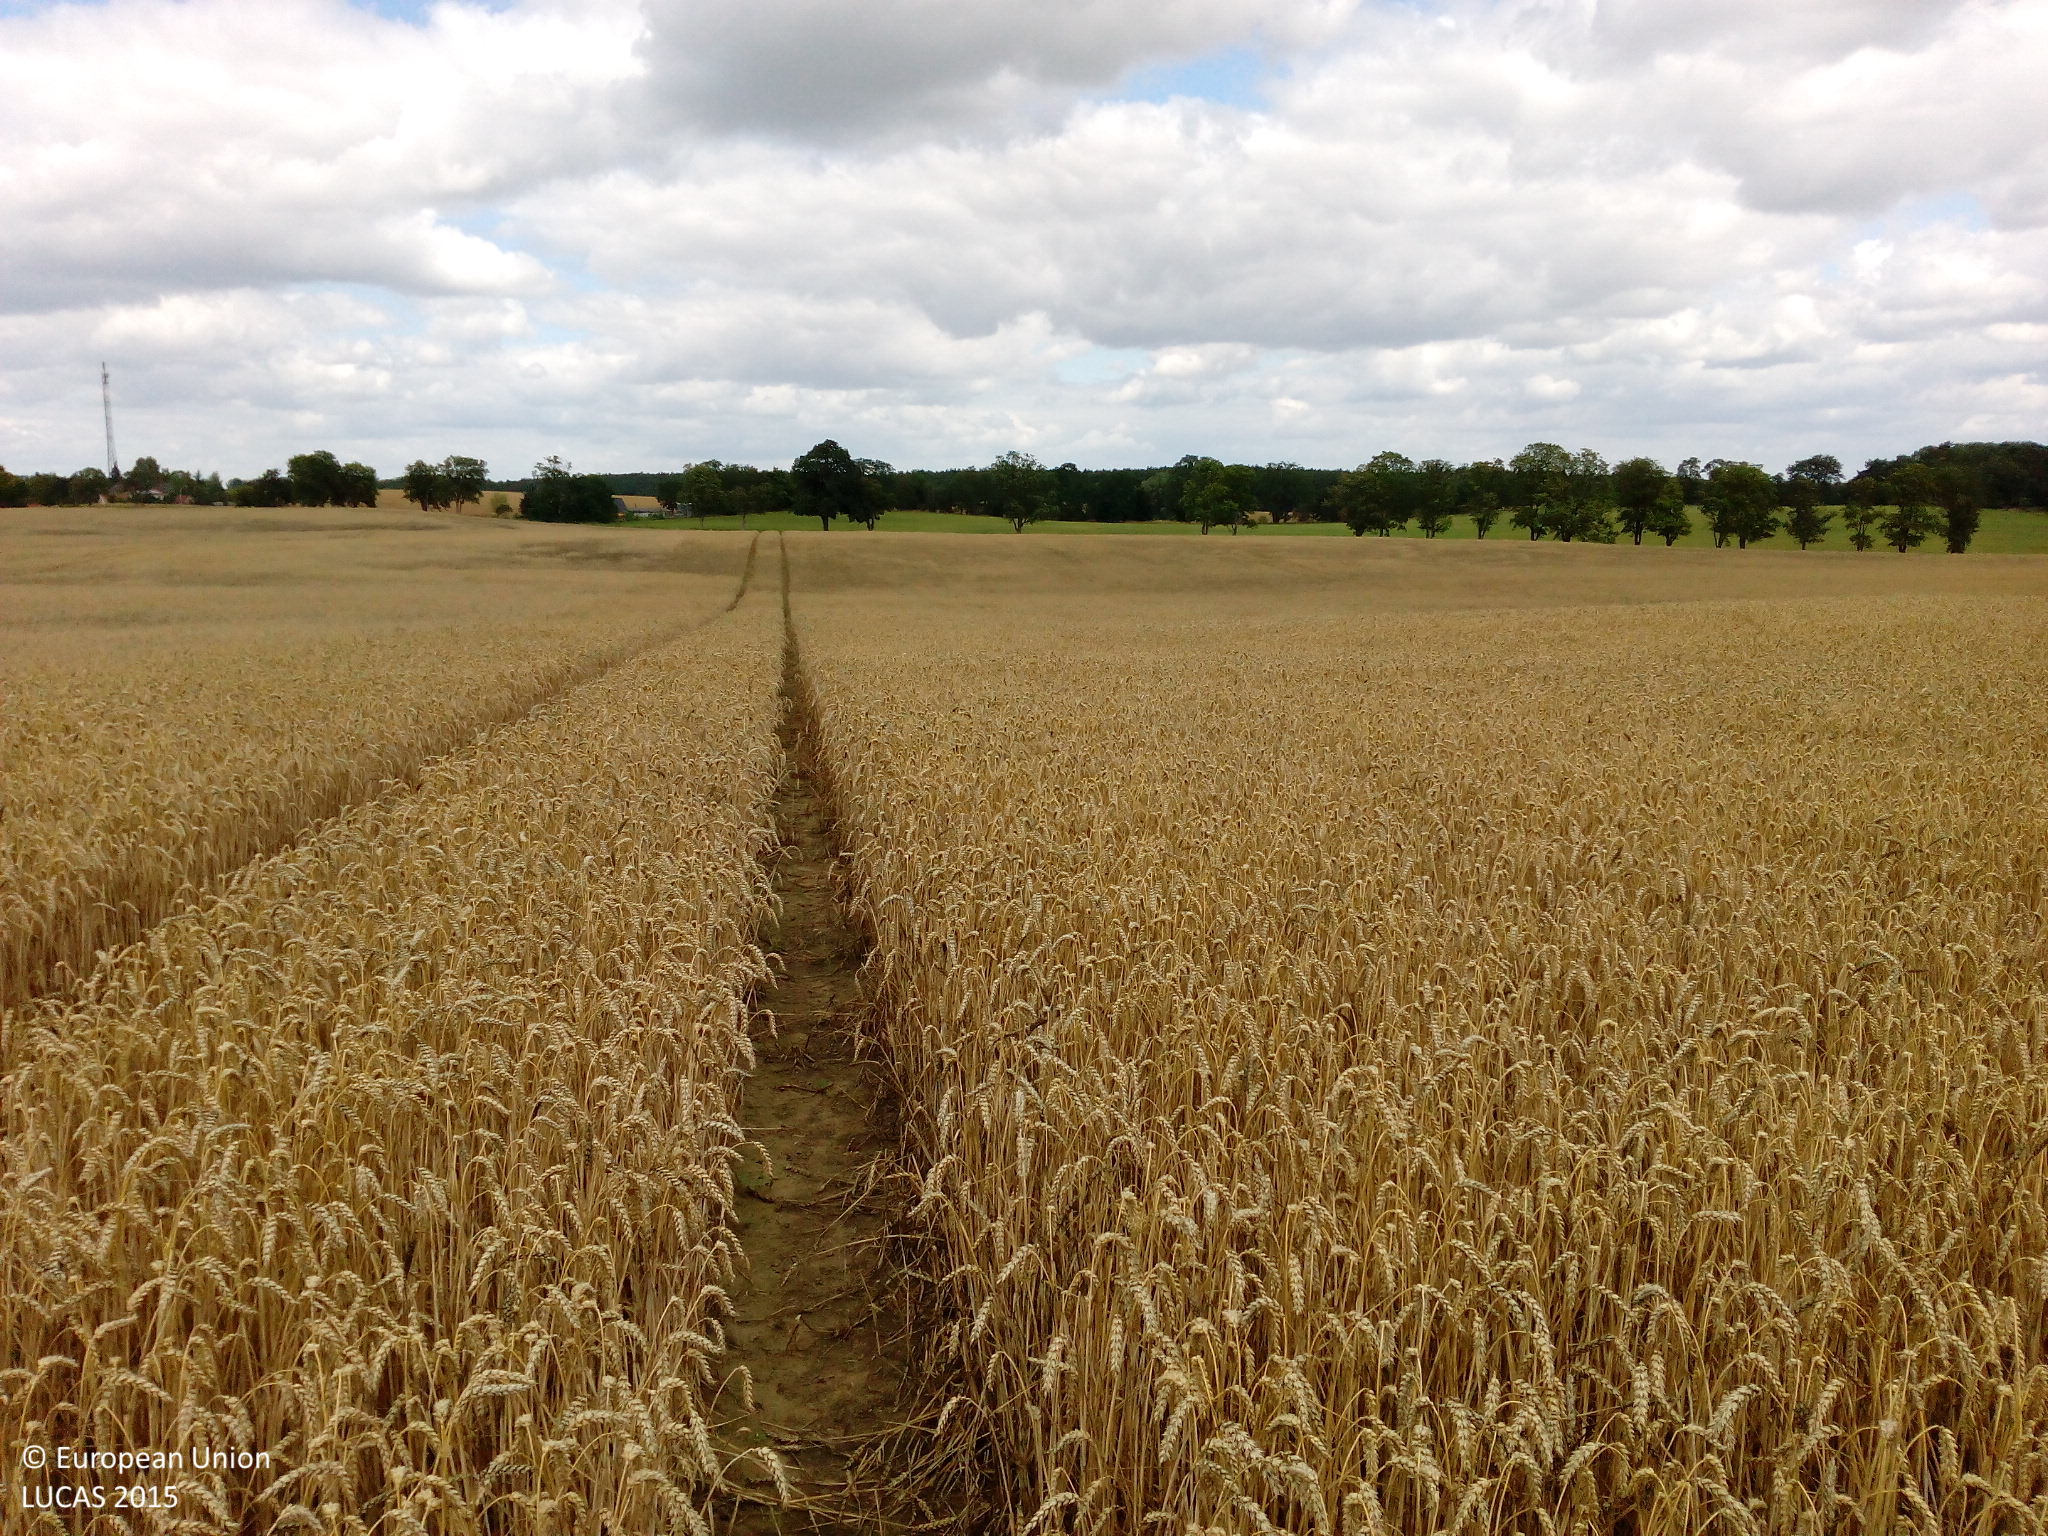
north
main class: Cropland
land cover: Common wheat
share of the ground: > 75 %
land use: Agriculture (excluding fallow land and kitchen gardens)
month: July
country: DE
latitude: 52.6109
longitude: 14.1508
